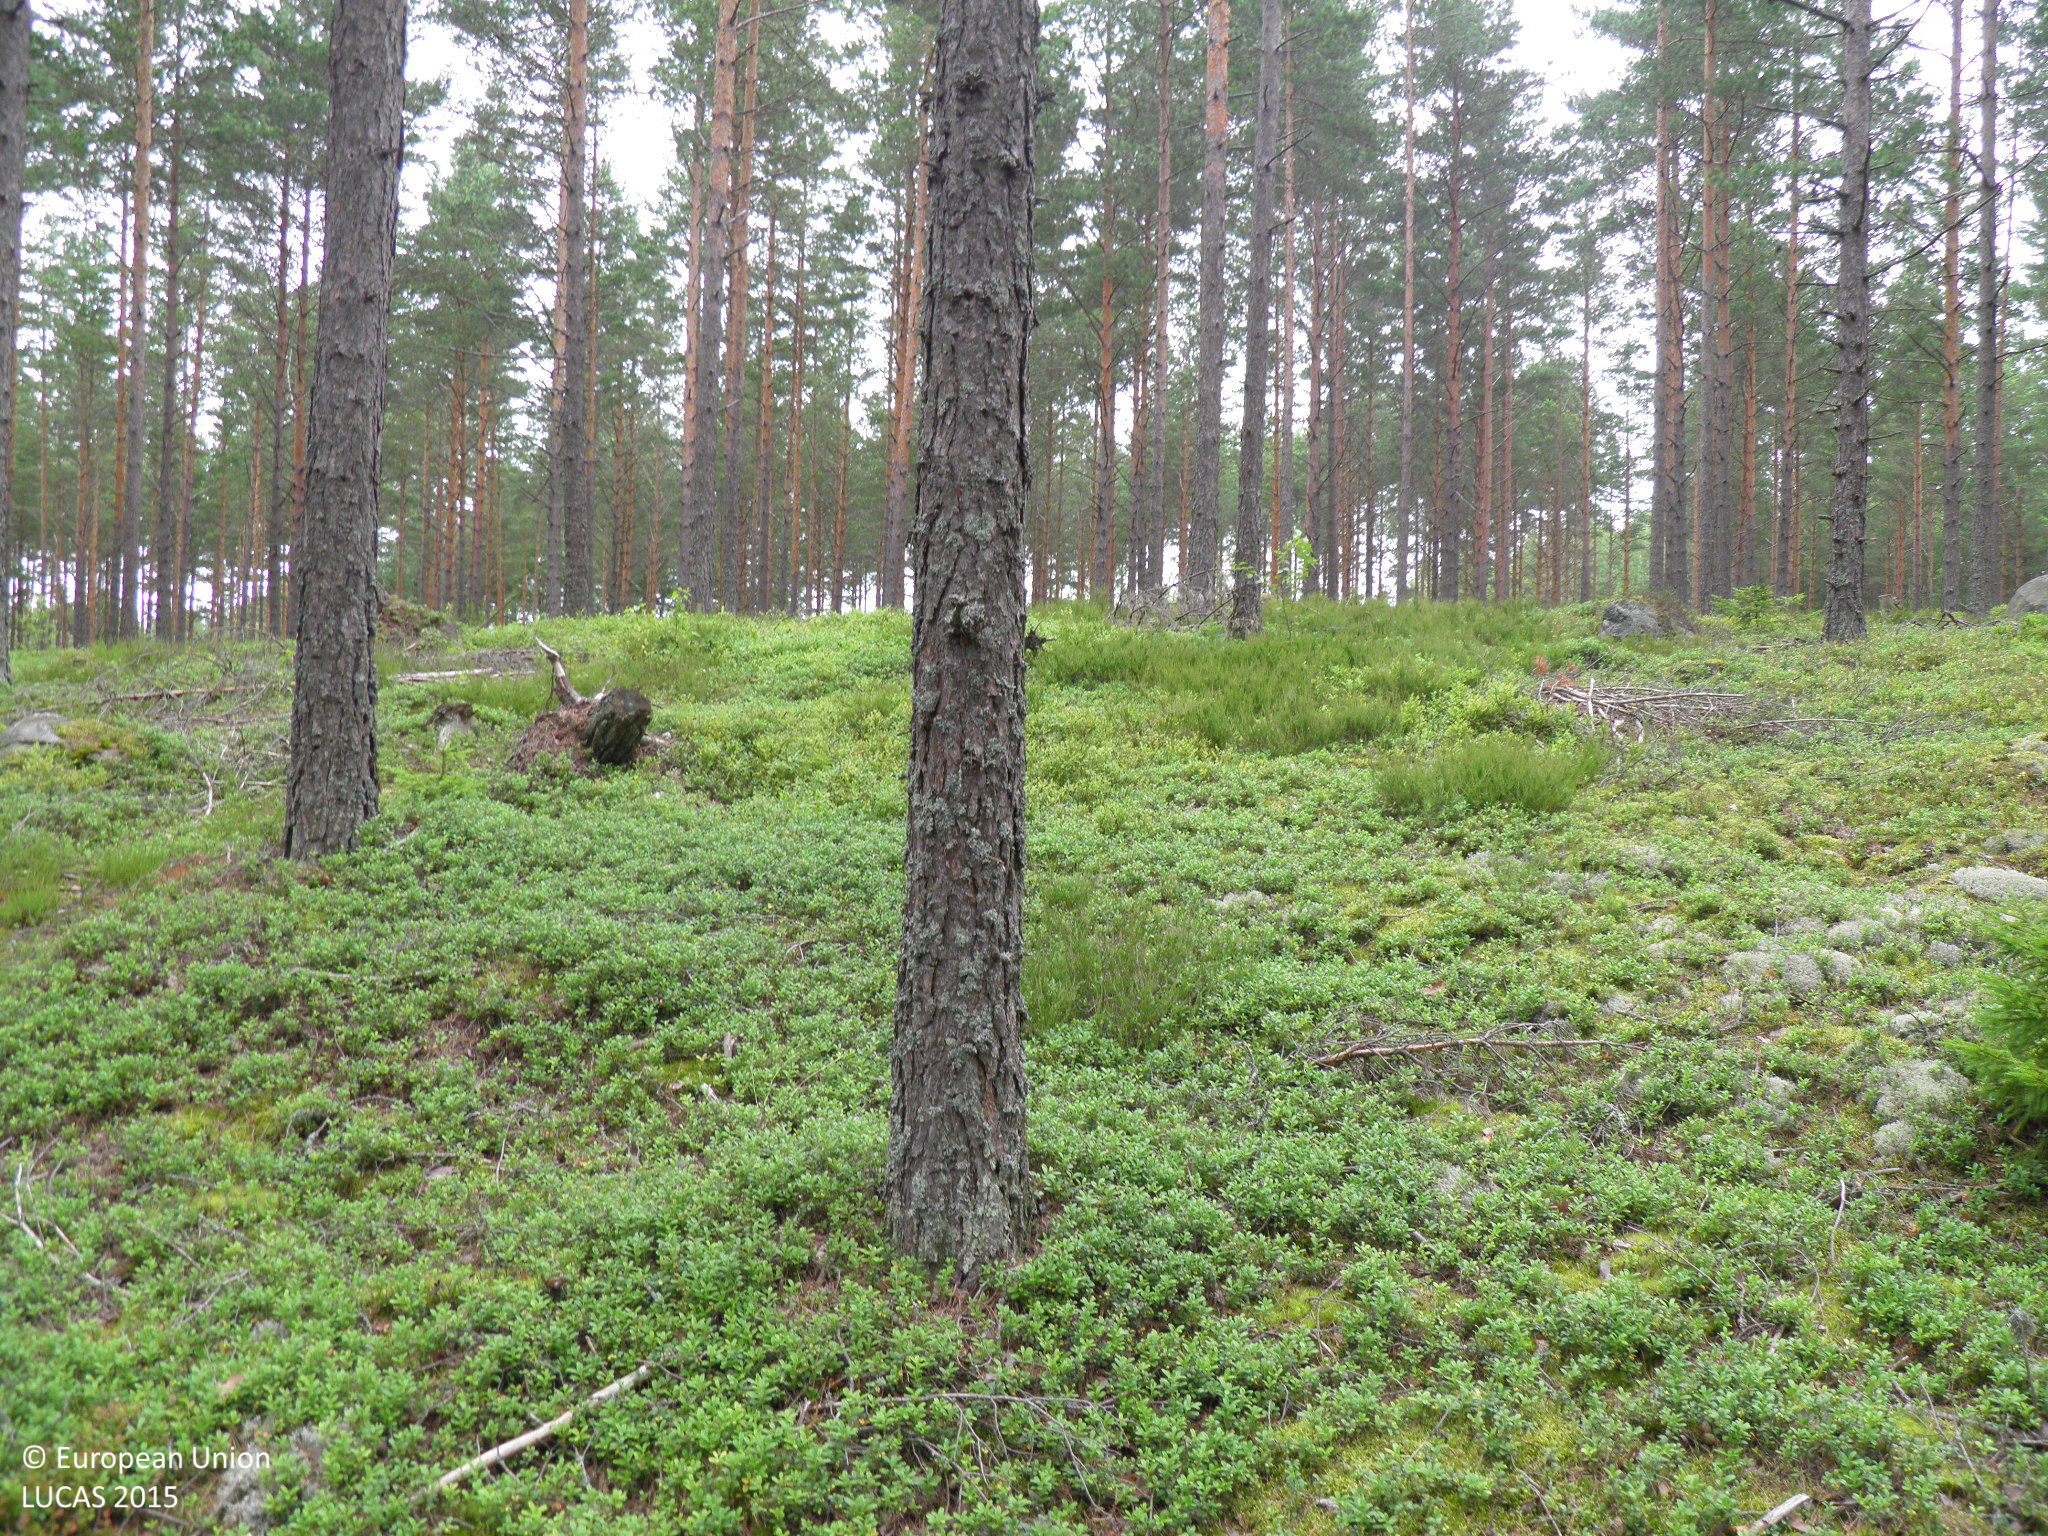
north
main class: Woodland
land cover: Pine dominated coniferous woodland
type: hemiboreal forest and nemoral coniferous forest and mixed broadleaved-coniferous forest
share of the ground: 25 - 50 %
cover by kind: coniferous forest trees 40 %, shrubs 40 %, lichens and mosses 20 %
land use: Forestry
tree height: > 5 m
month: July
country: FI
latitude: 60.1948
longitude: 22.8289
